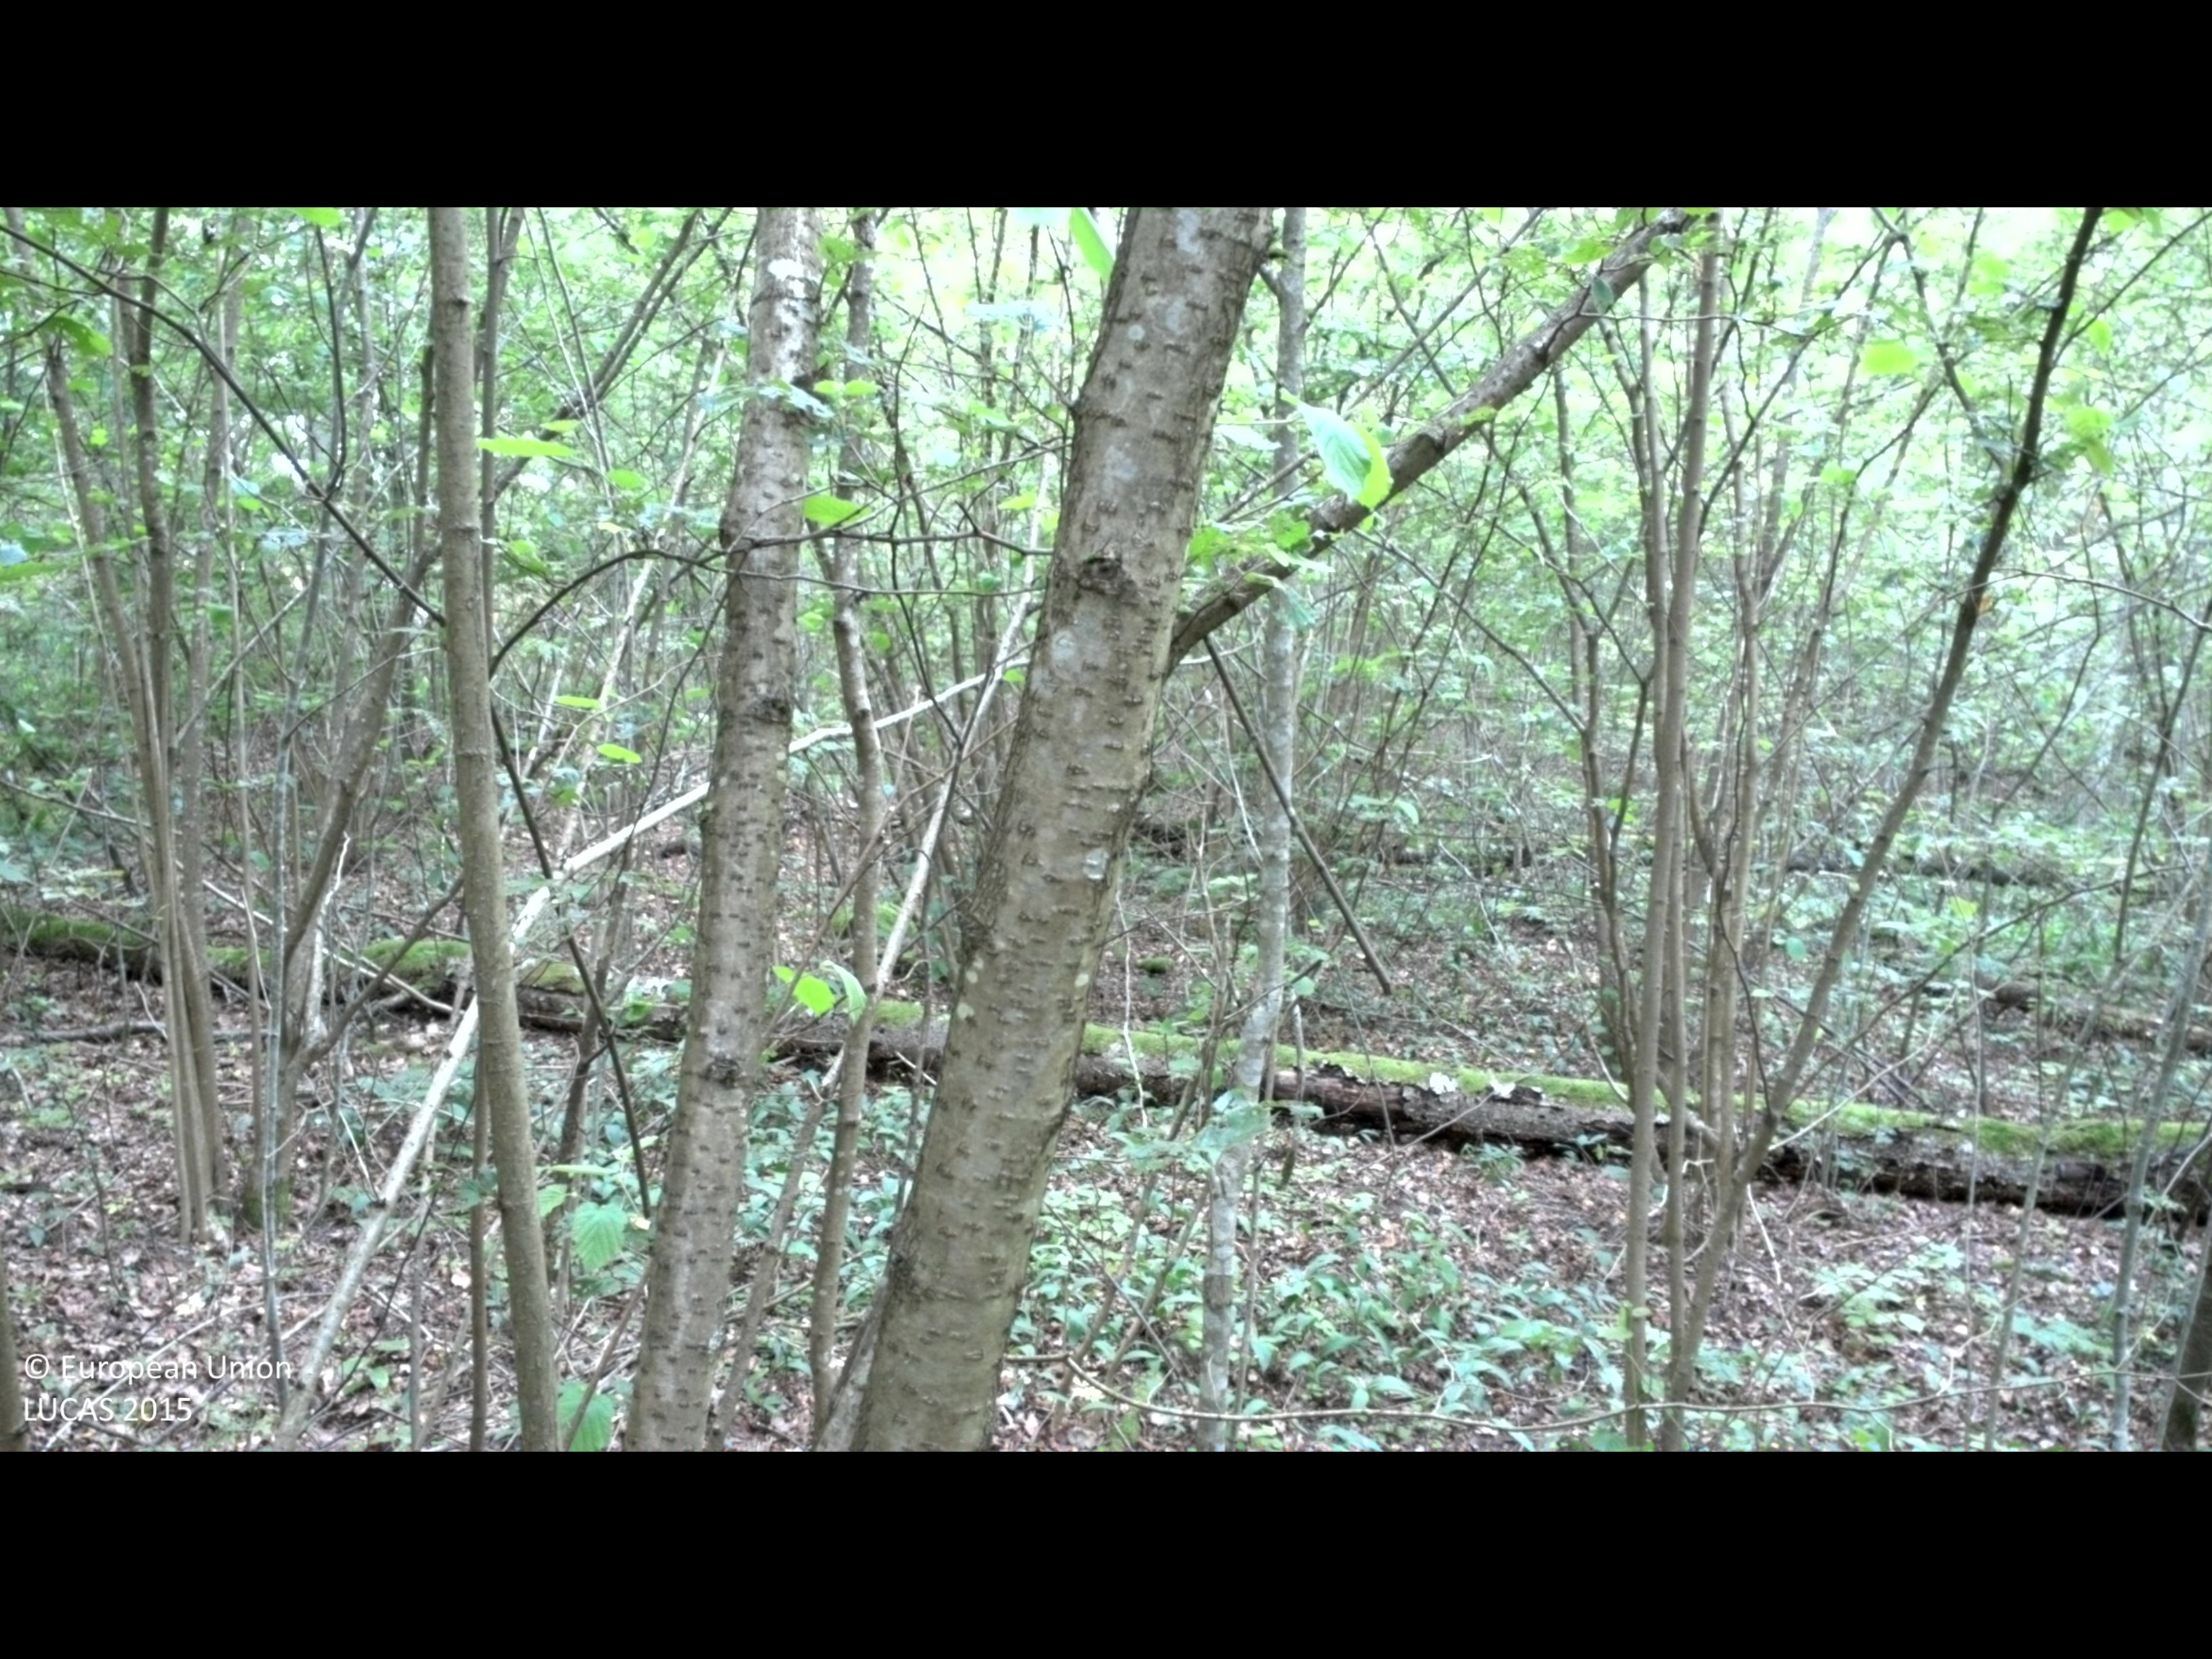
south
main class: Woodland
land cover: Broadleaved woodland
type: boreal forest
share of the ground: > 75 %
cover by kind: broadleaved forest trees 75 %, shrubs 20 %, herbaceous plants 5 %
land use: Forestry
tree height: > 5 m
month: July
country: SE
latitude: 56.8161
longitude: 13.7808
